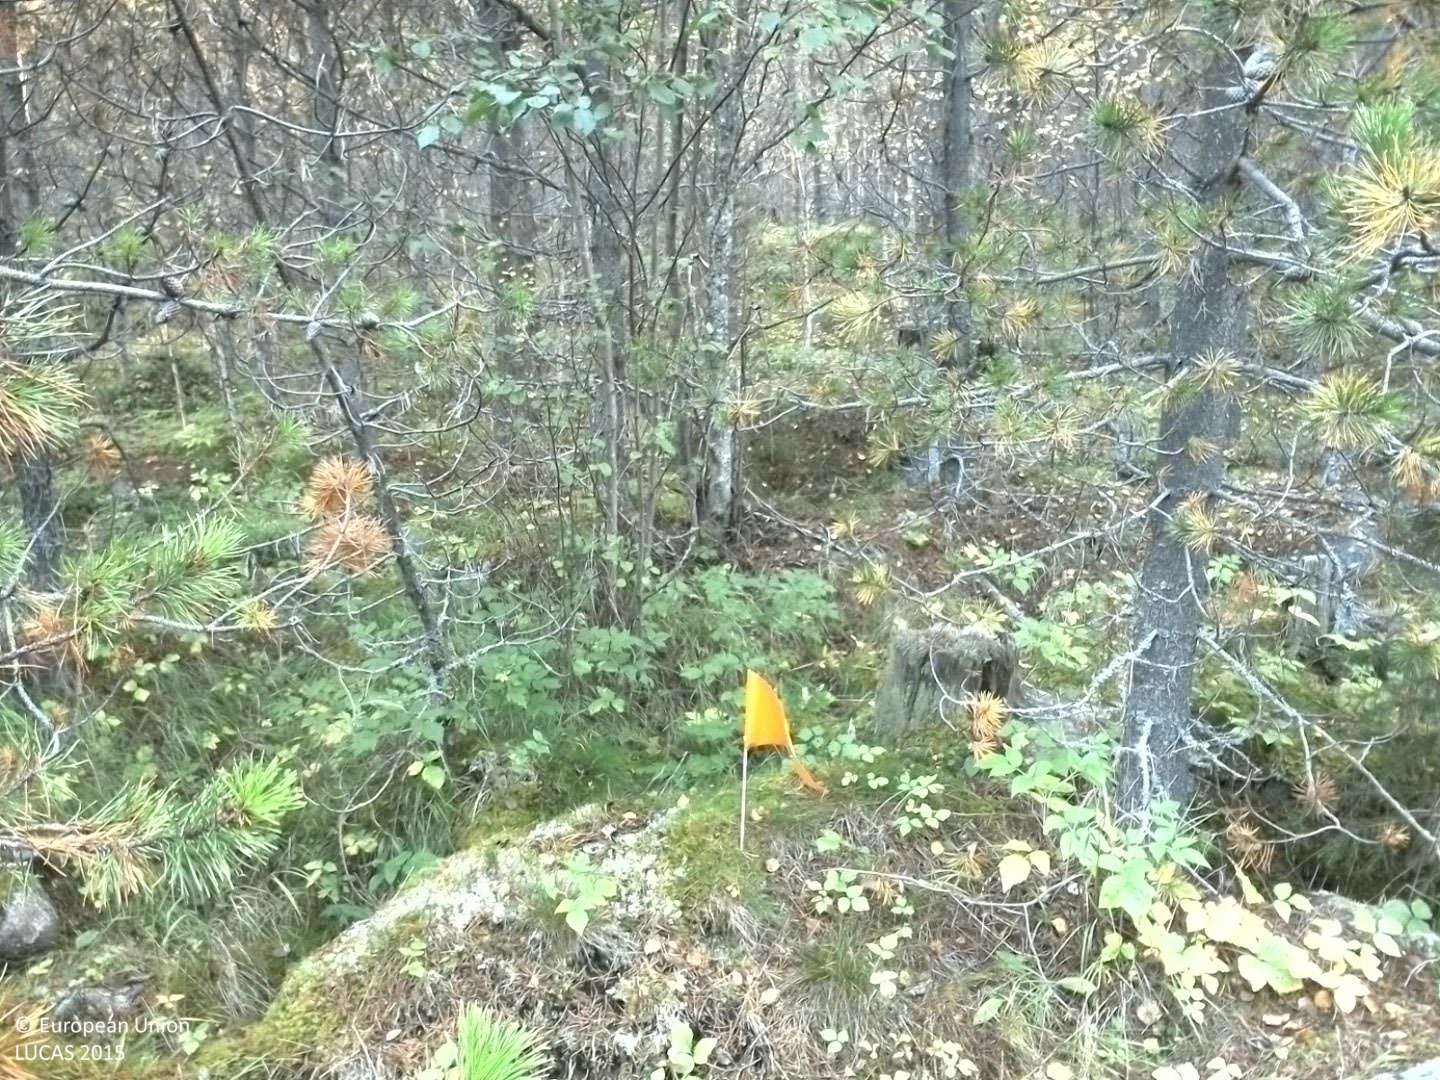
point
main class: Woodland
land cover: Pine dominated coniferous woodland
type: exotic forest
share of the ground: 50 - 75 %
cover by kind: coniferous forest trees 50 %, herbaceous plants 30 %, shrubs 15 %, broadleaved forest trees 5 %
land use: Forestry
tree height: > 5 m
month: September
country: SE
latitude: 62.2888
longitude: 15.6670
